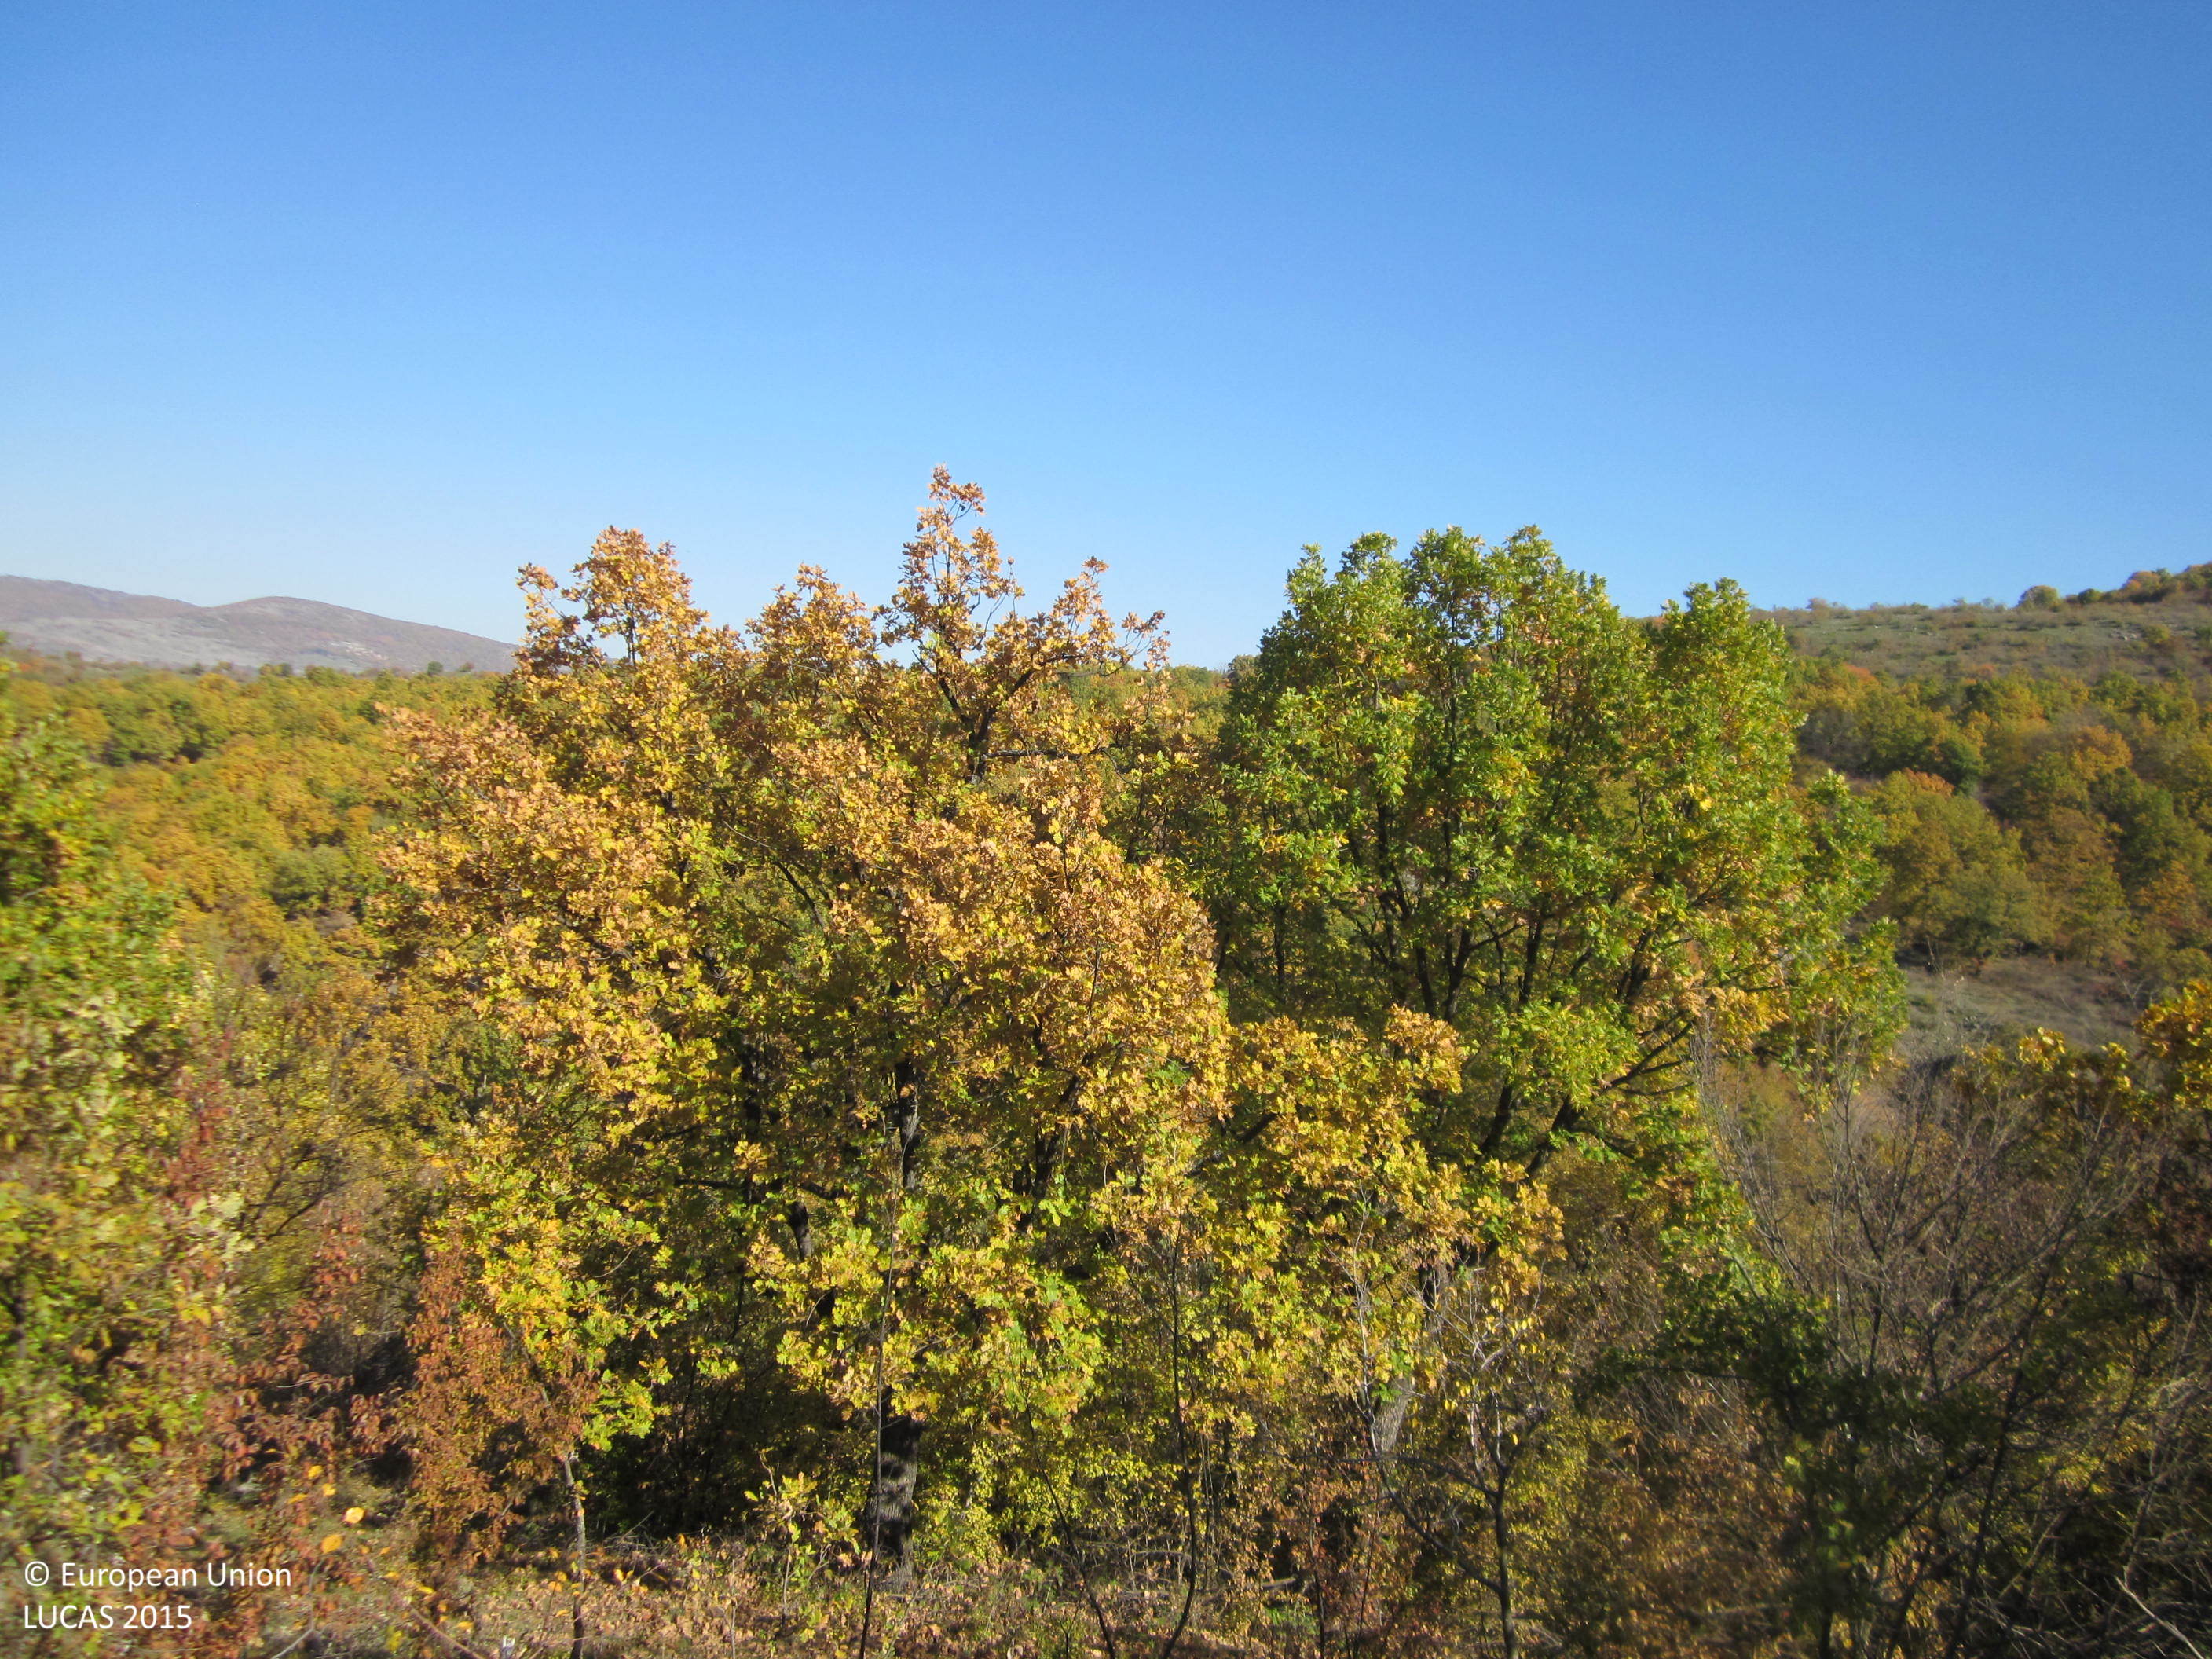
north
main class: Woodland
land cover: Broadleaved woodland
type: acidophilous oak and oak-birch forest
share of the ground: 50 - 75 %
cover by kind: broadleaved forest trees 60 %, herbaceous plants 30 %, shrubs 10 %
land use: Forestry
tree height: > 5 m
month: November
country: BG
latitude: 41.5315
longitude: 25.5805
